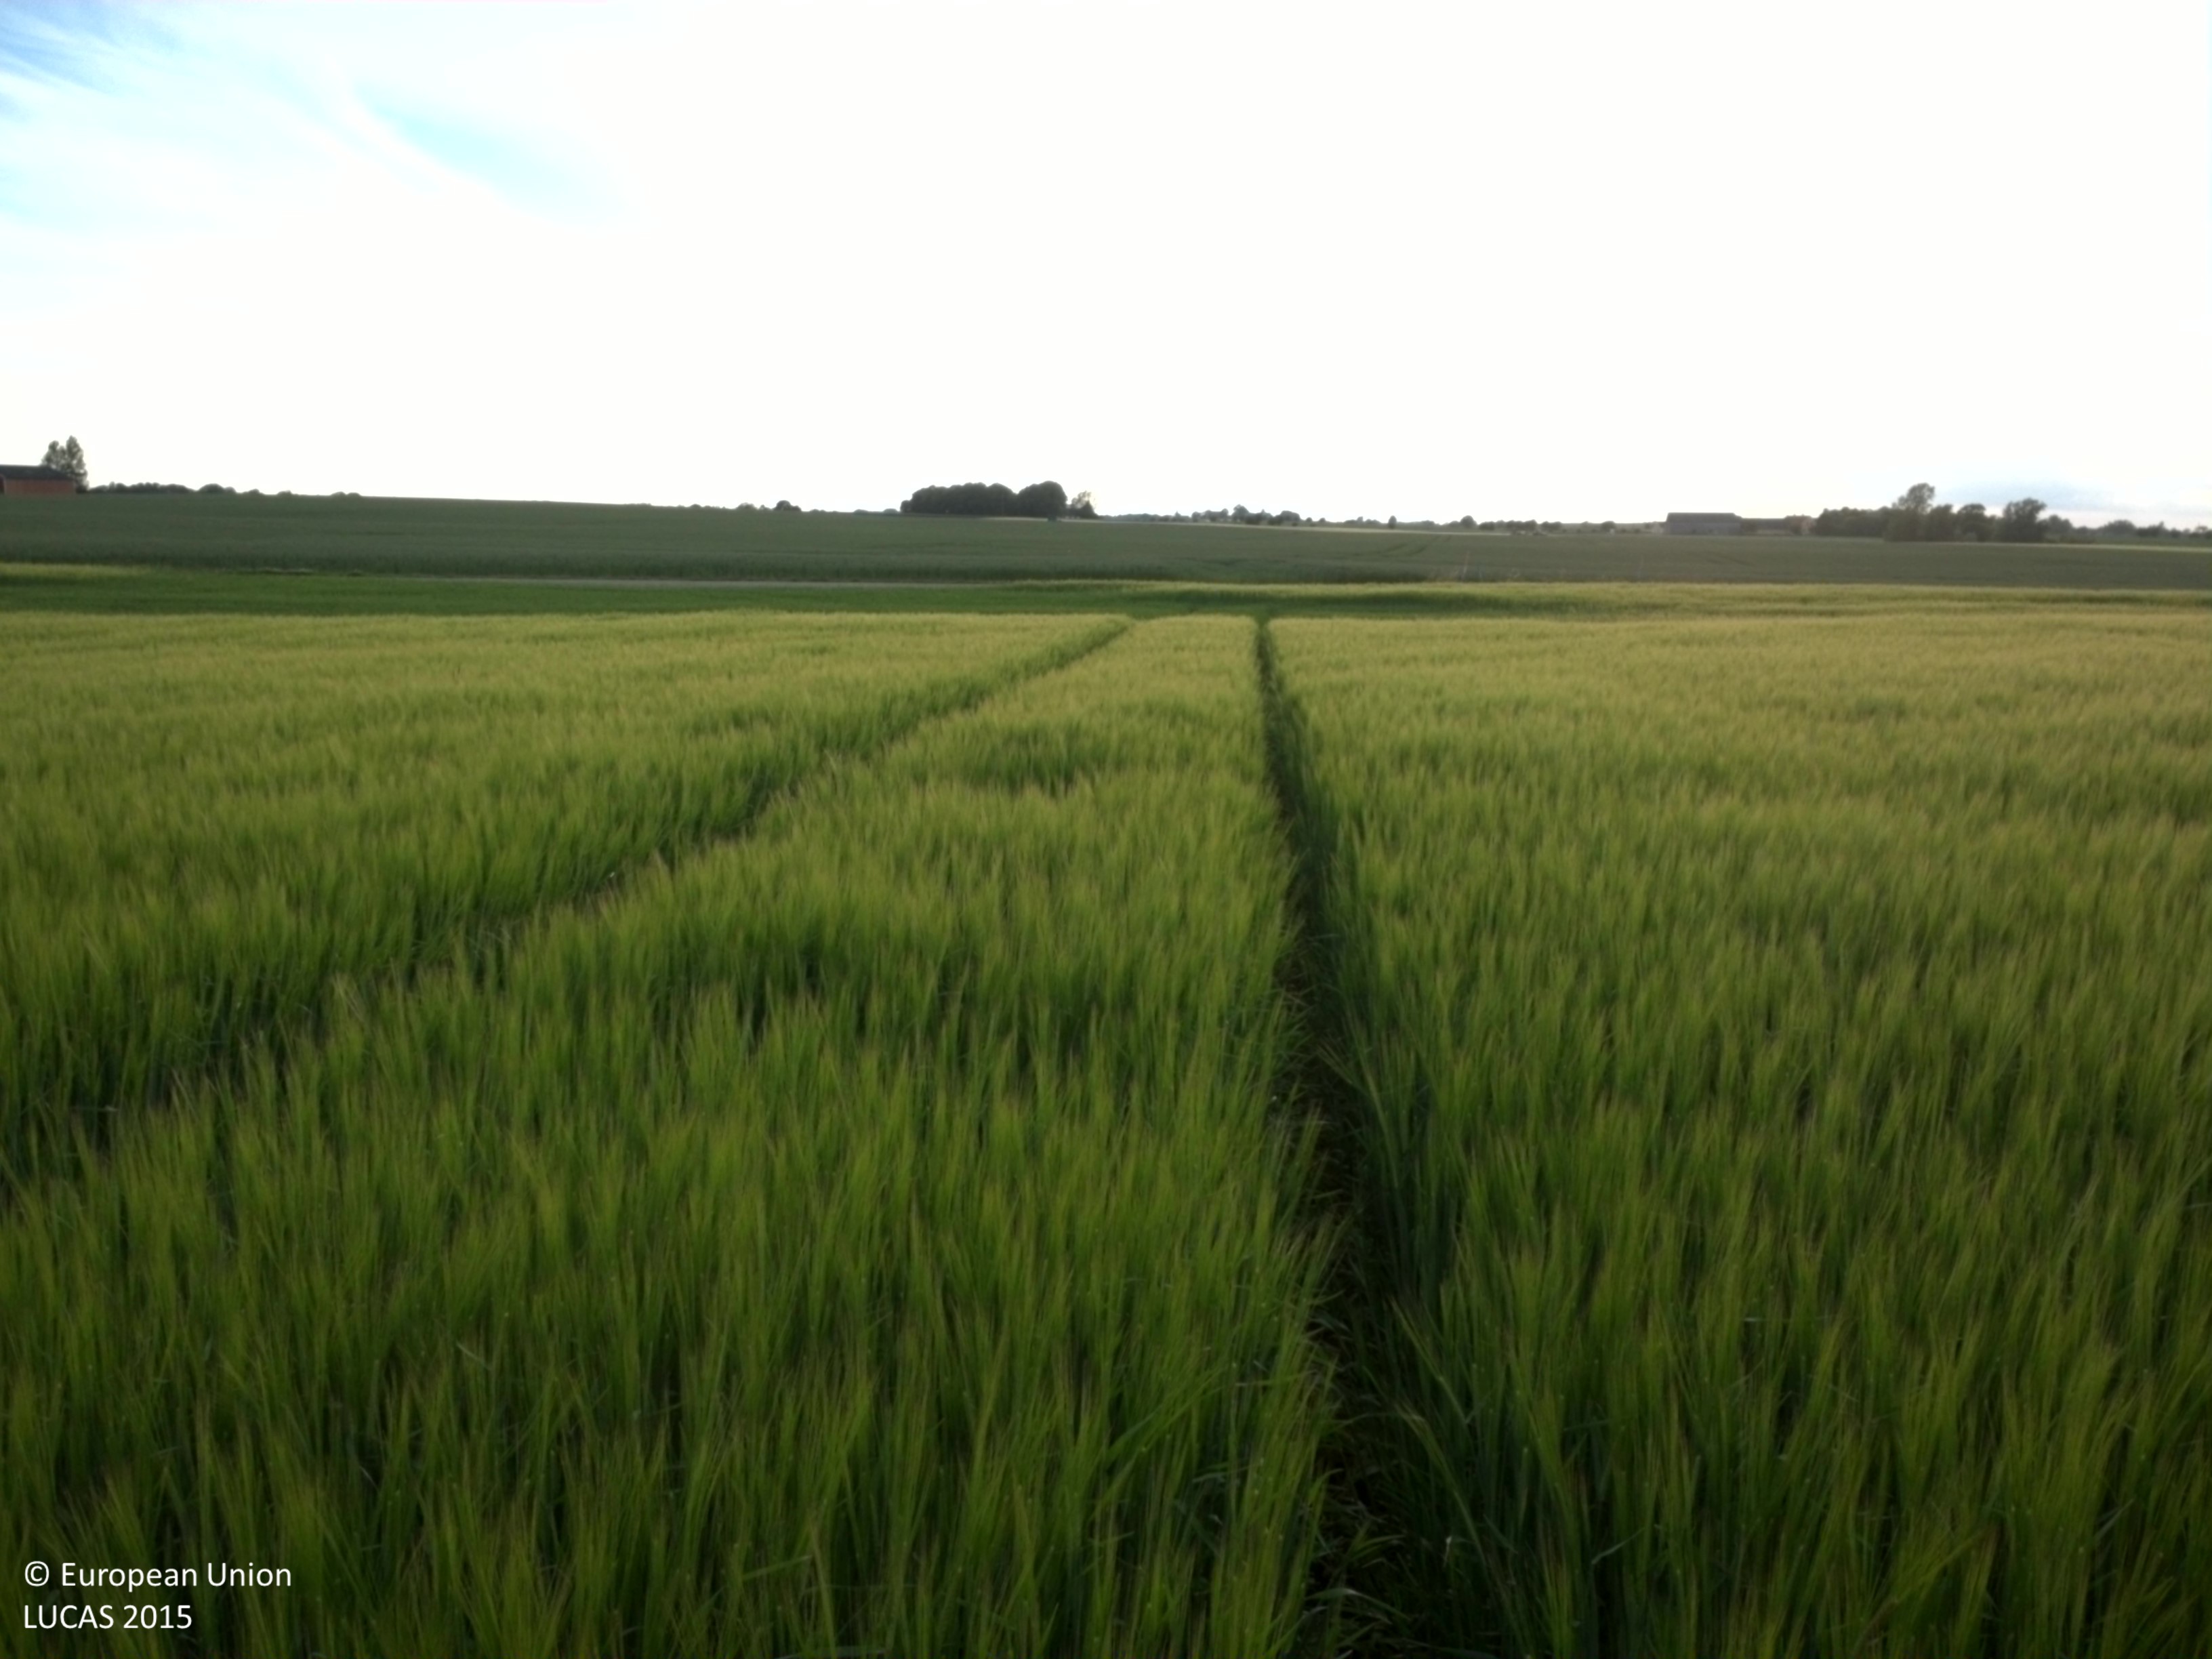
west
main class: Cropland
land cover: Barley
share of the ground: > 75 %
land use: Agriculture (excluding fallow land and kitchen gardens)
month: June
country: SE
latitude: 55.4305
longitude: 13.1113
